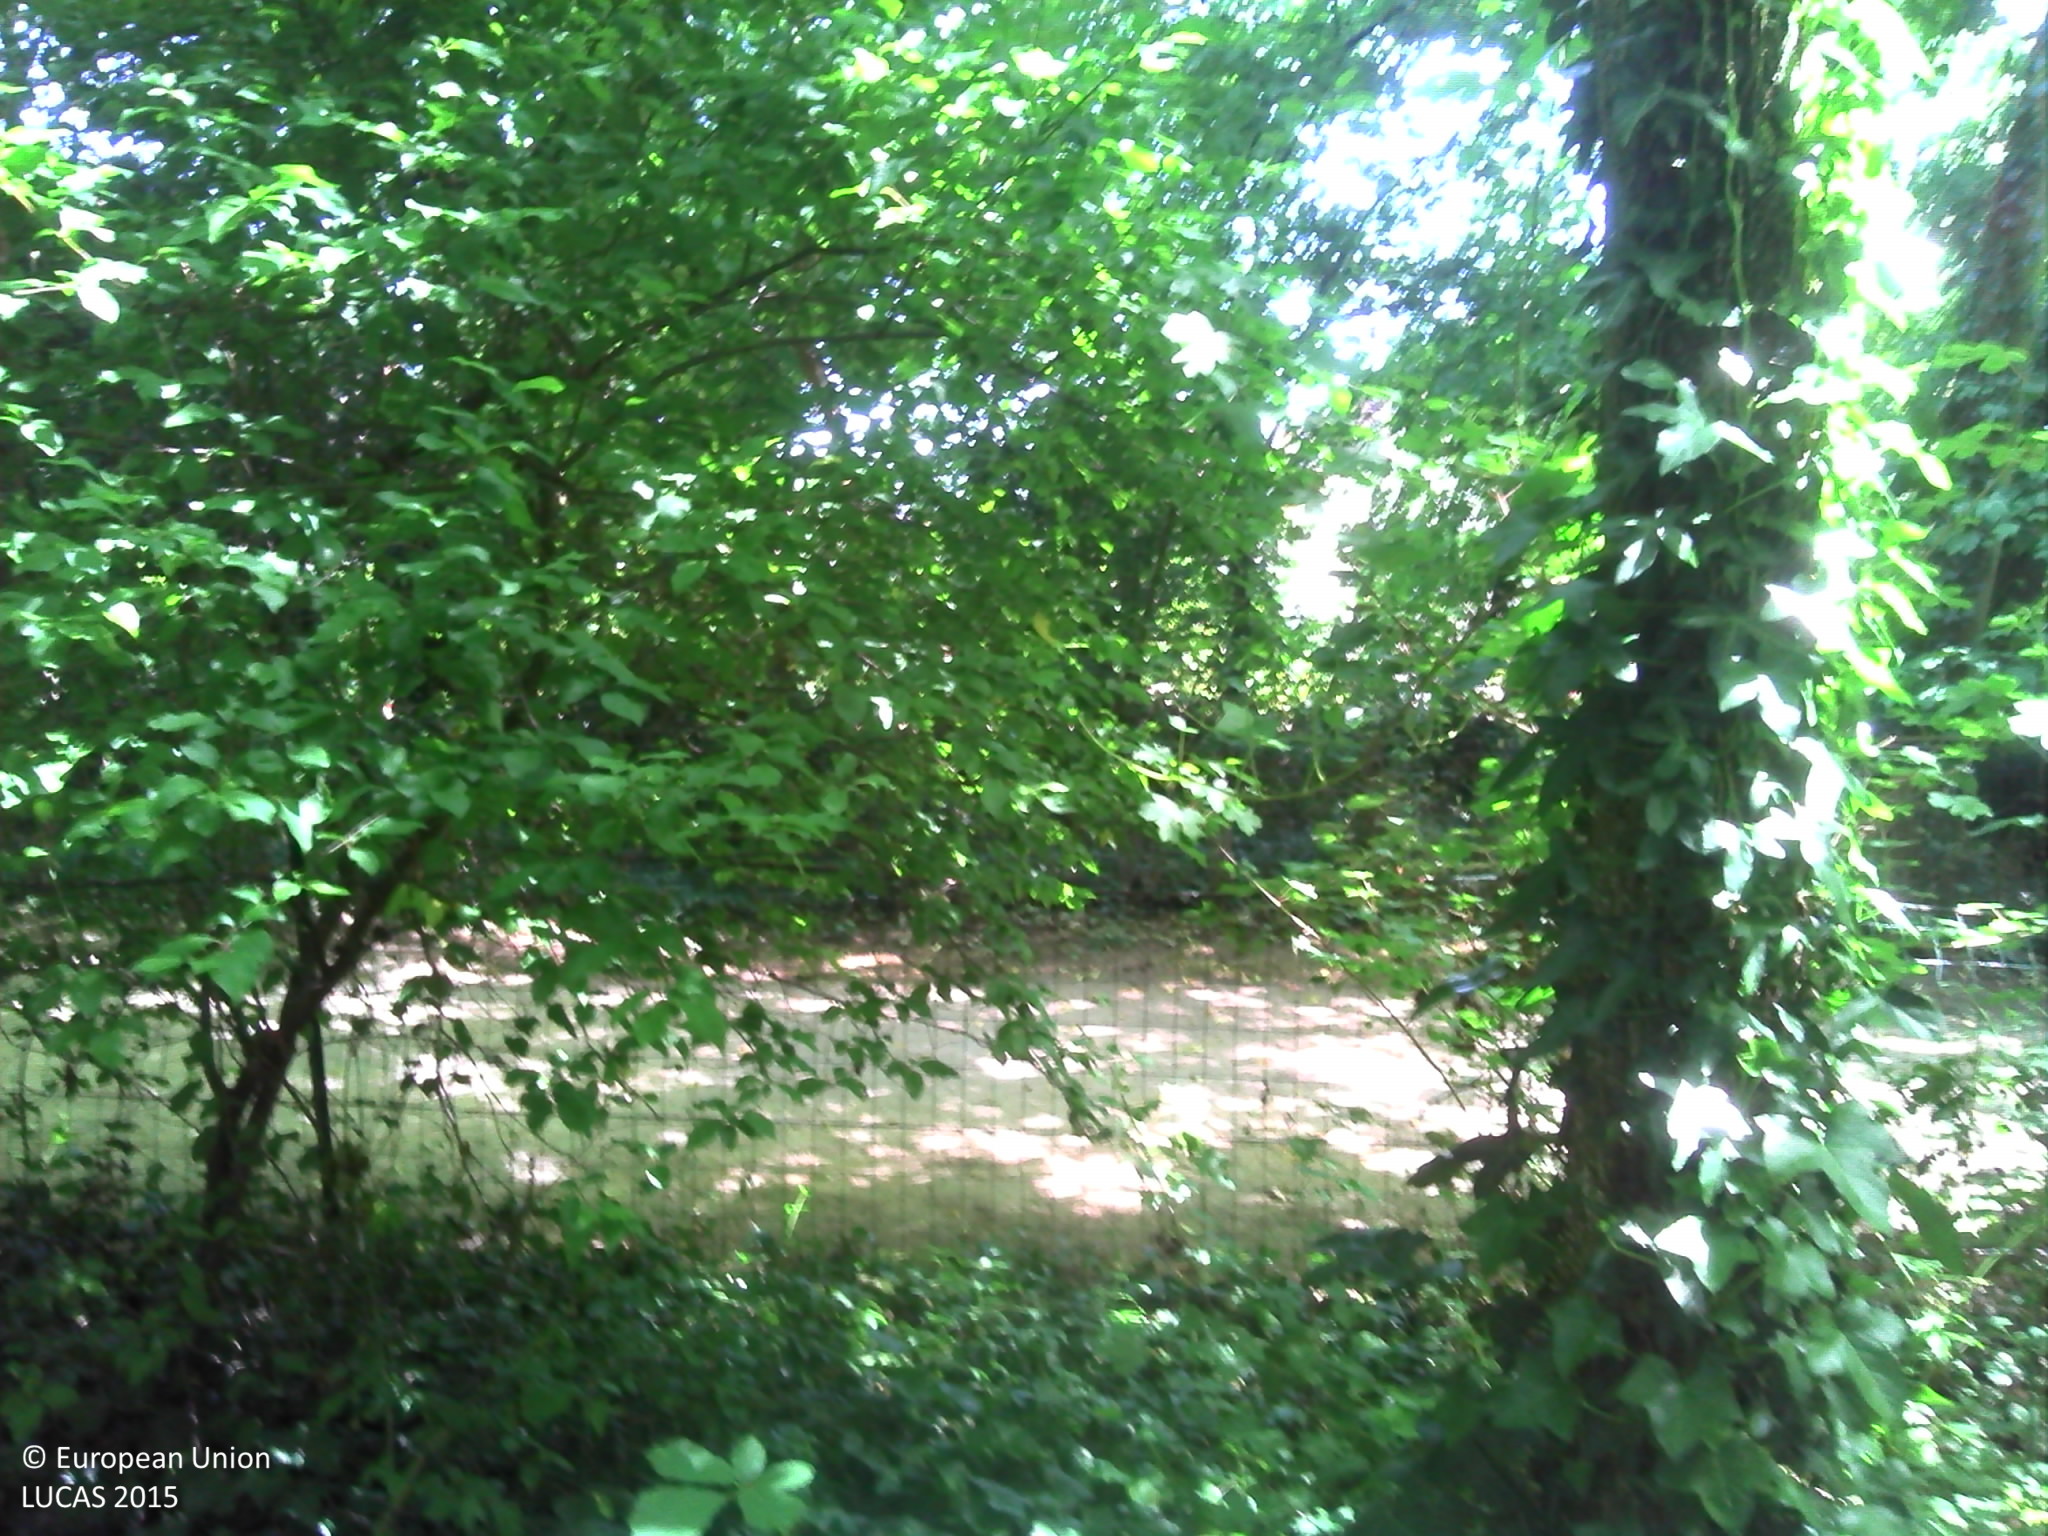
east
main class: Woodland
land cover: Broadleaved woodland
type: mesophytic deciduous forest
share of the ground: > 75 %
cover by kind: broadleaved forest trees 75 %, shrubs 20 %, herbaceous plants 5 %
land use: Amenities, museums, leisure
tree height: > 5 m
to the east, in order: Broadleaved woodland; Fences; Tracks; Fences; Broadleaved woodland; Artificial constructions in urban areas
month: June
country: FR
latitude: 49.1515
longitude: -0.3311
